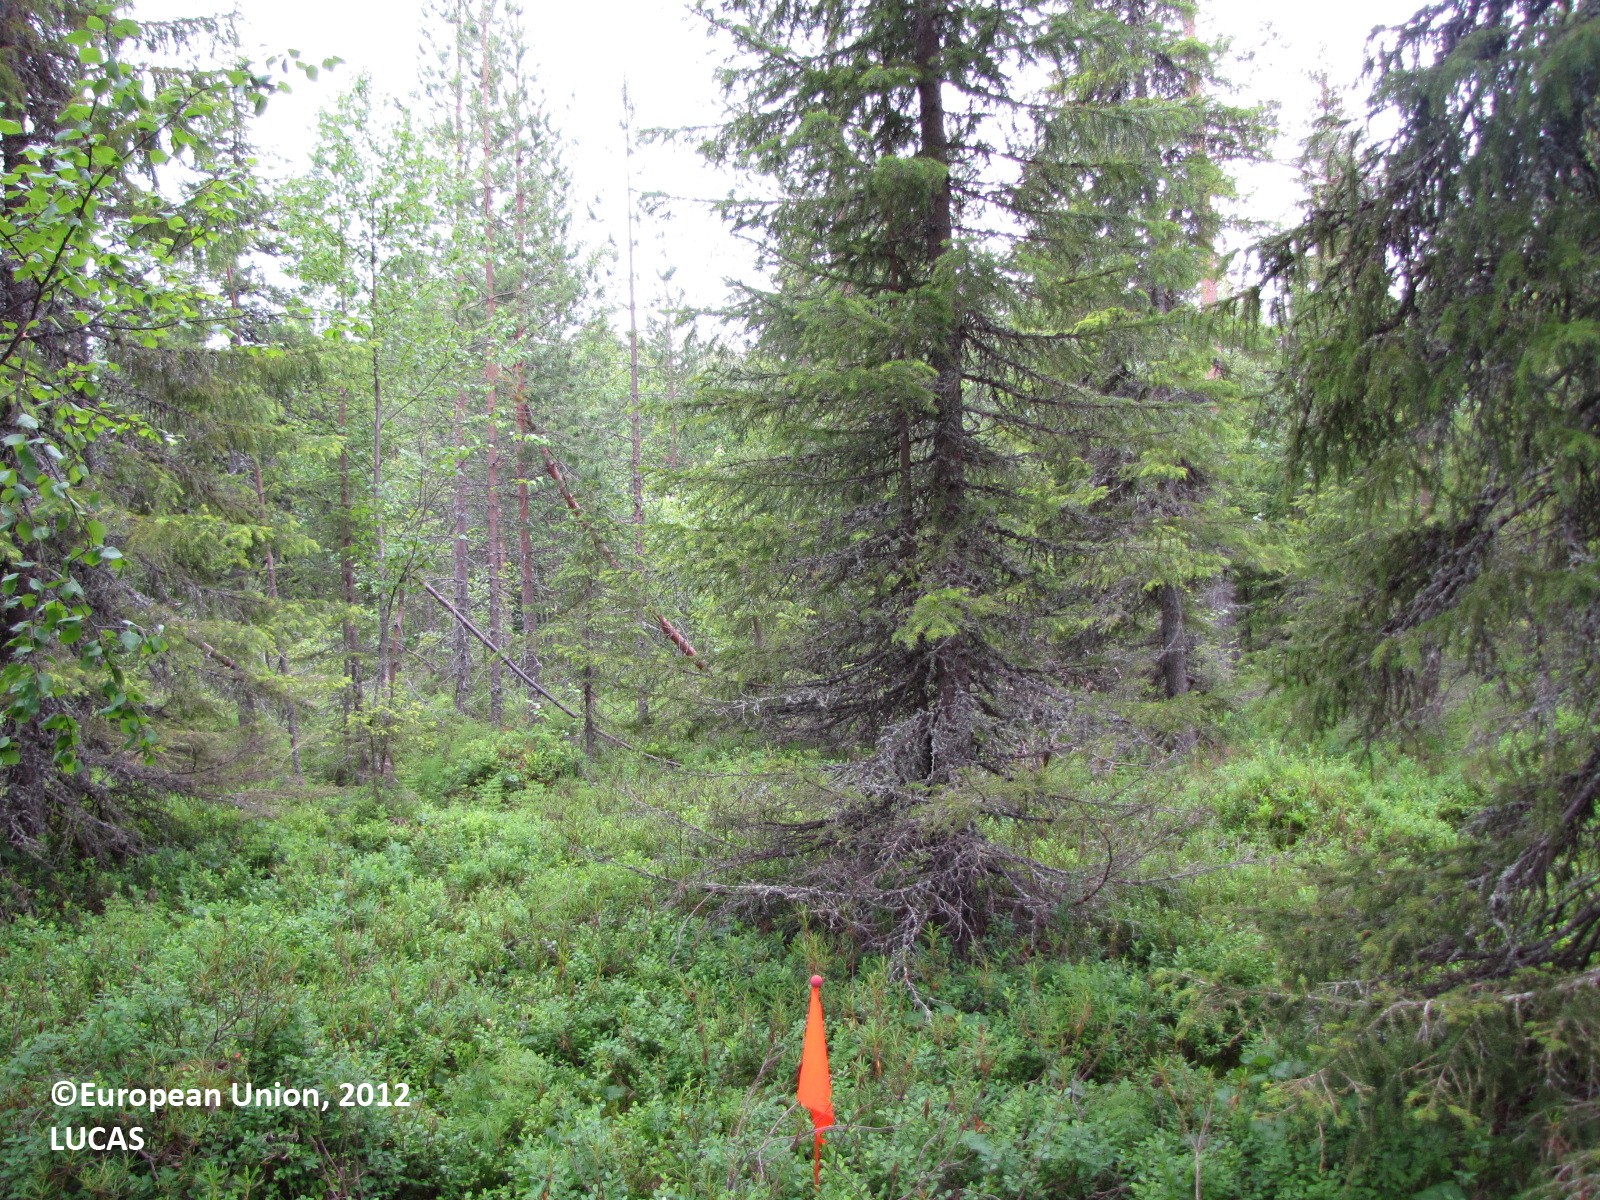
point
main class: Woodland
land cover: Spruce dominated mixed woodland
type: boreal forest
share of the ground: 25 - 50 %
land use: Forestry
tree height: > 5 m
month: July
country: FI
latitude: 66.5324
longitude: 24.9266
